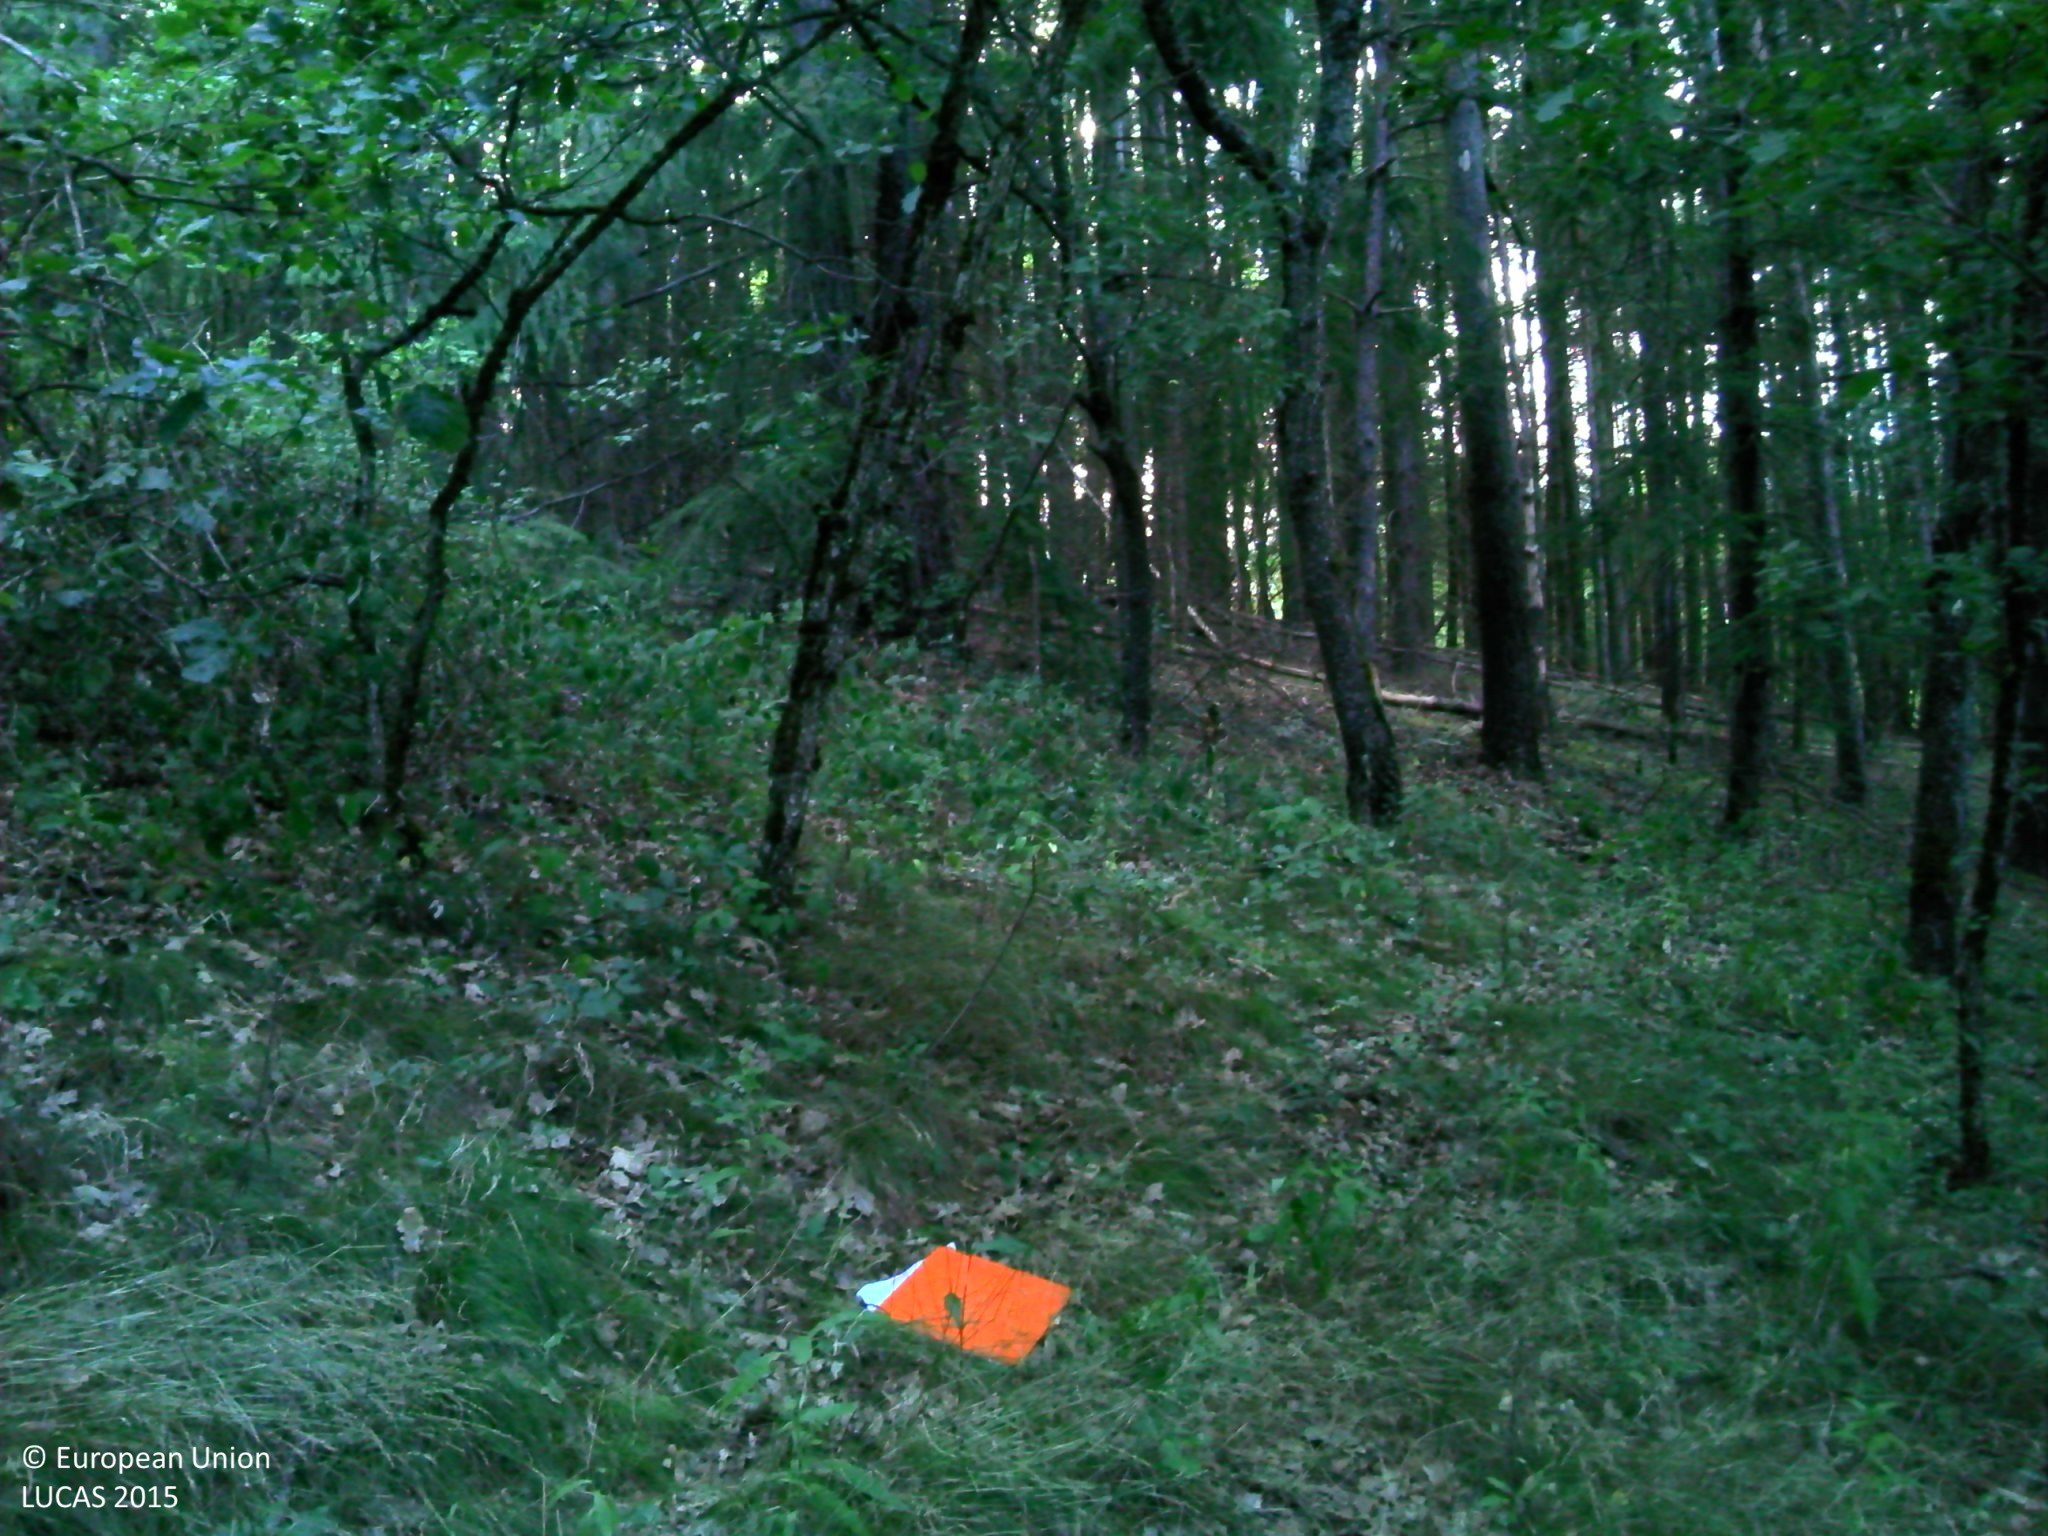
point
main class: Woodland
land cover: Spruce dominated mixed woodland
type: acidophilous oak and oak-birch forest
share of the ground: > 75 %
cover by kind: coniferous forest trees 75 %, broadleaved forest trees 25 %
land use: Forestry
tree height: > 5 m
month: July
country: FR
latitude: 45.1221
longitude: 3.4813
